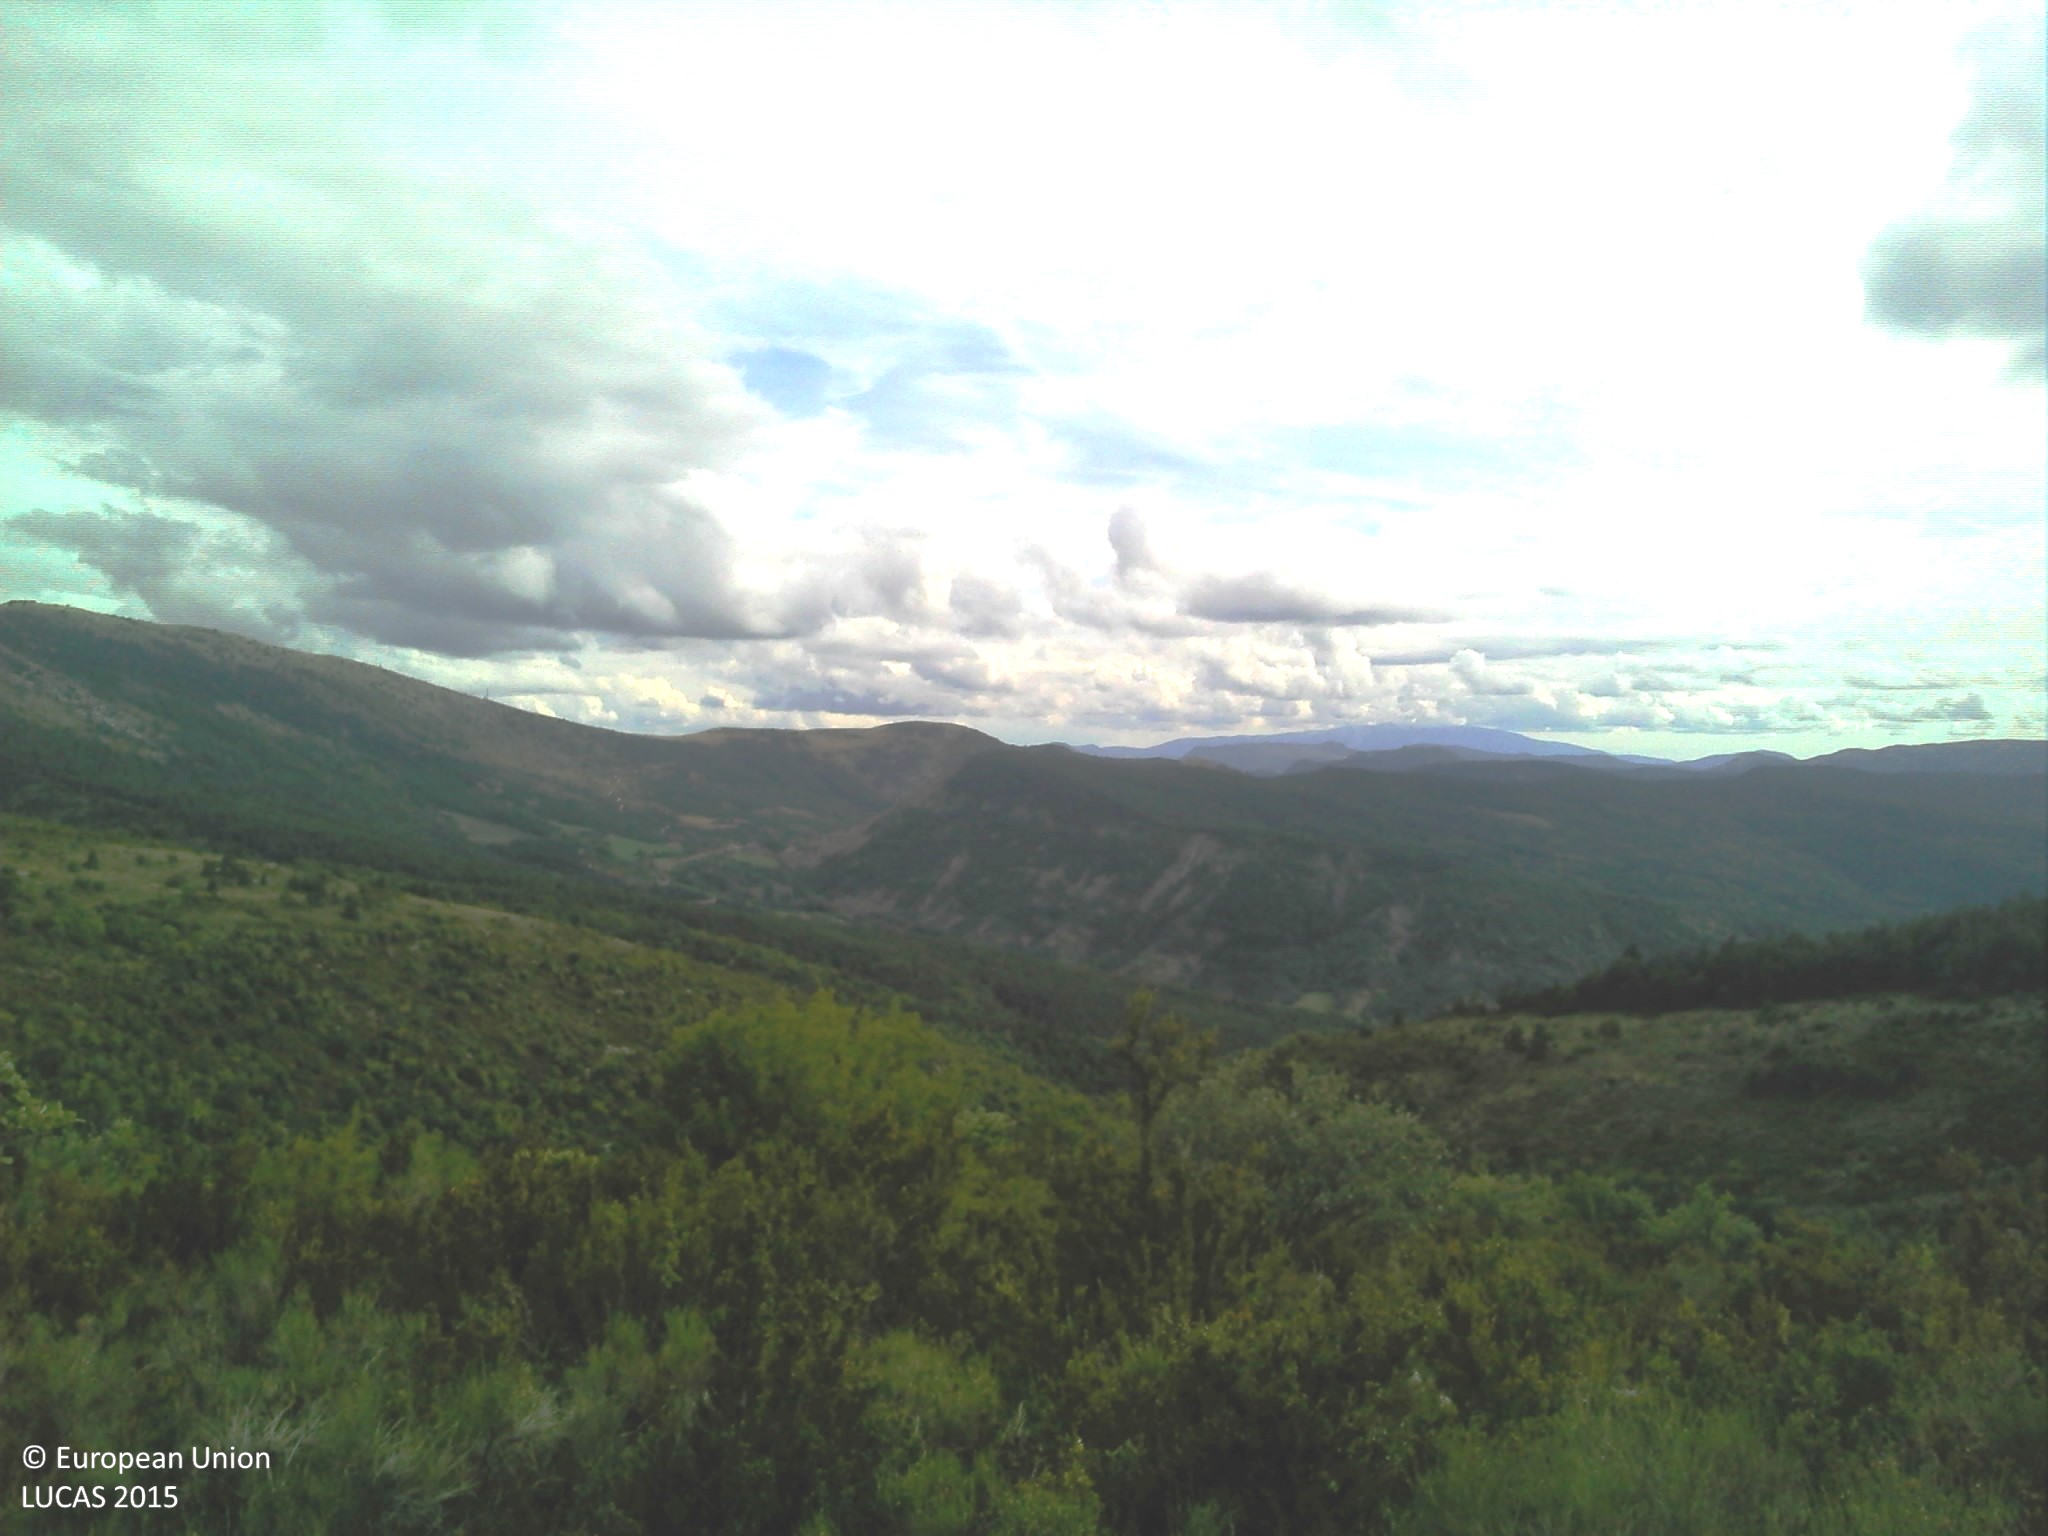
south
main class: Shrubland
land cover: Shrubland without tree cover
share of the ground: > 75 %
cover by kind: shrubs 95 %, consolidated bare surface 5 %
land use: Semi-natural and natural areas not in use
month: September
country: FR
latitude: 44.5719
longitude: 5.3602
